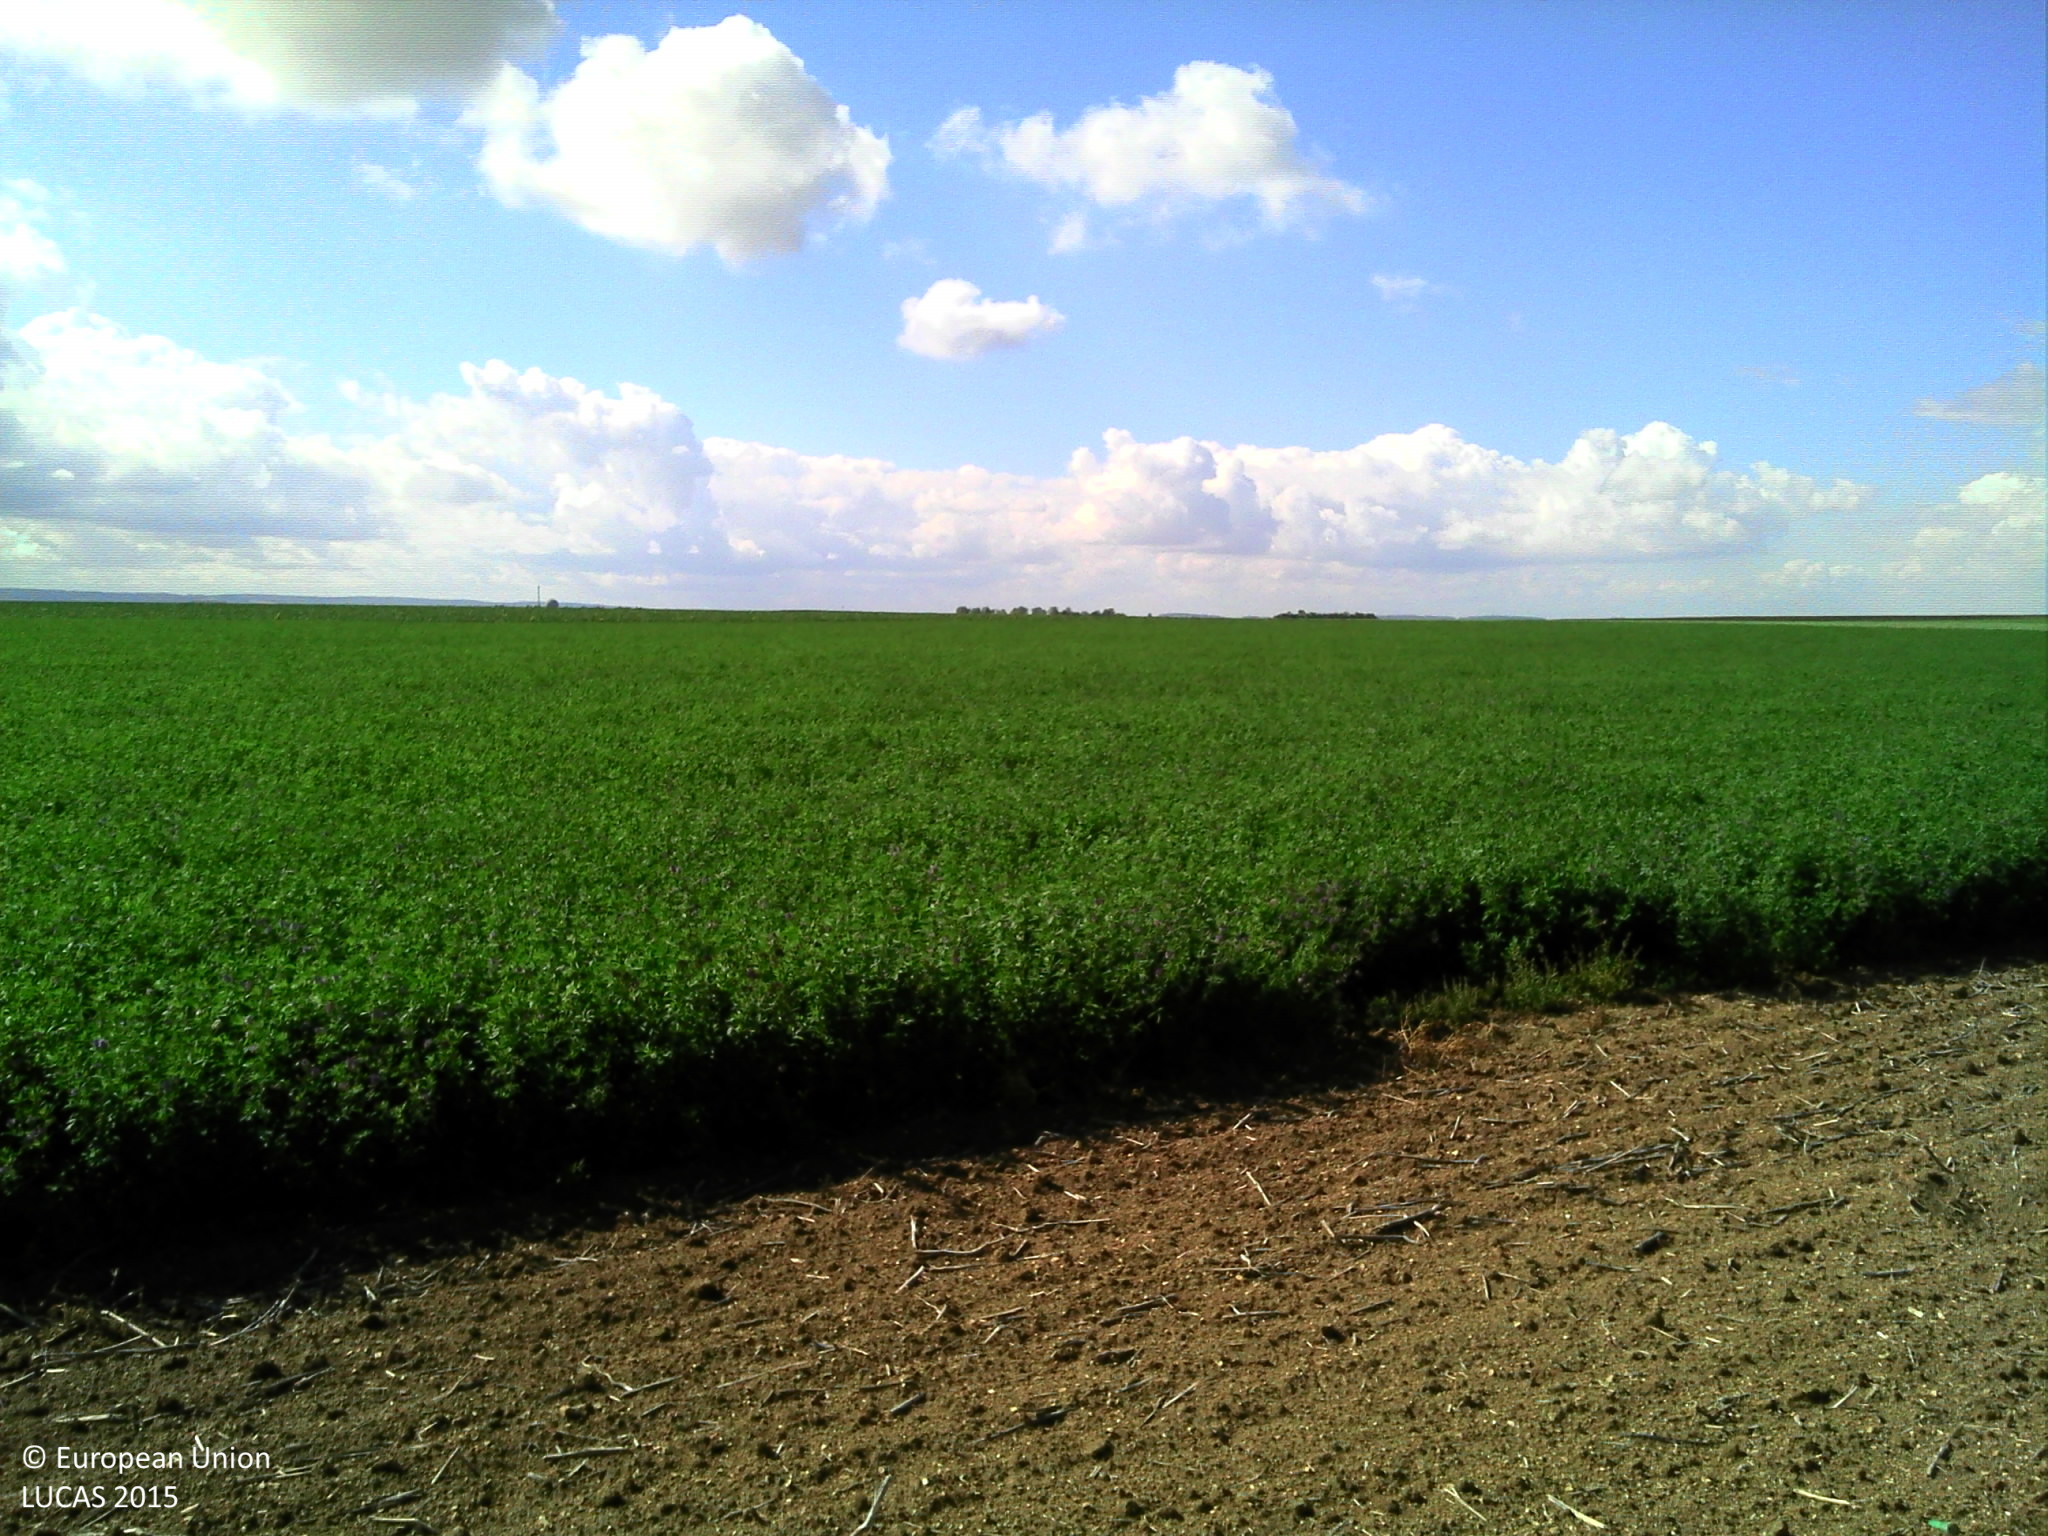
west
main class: Cropland
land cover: Rape and turnip rape
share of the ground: 25 - 50 %
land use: Agriculture (excluding fallow land and kitchen gardens)
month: September
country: FR
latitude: 48.3753
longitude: 3.8256
